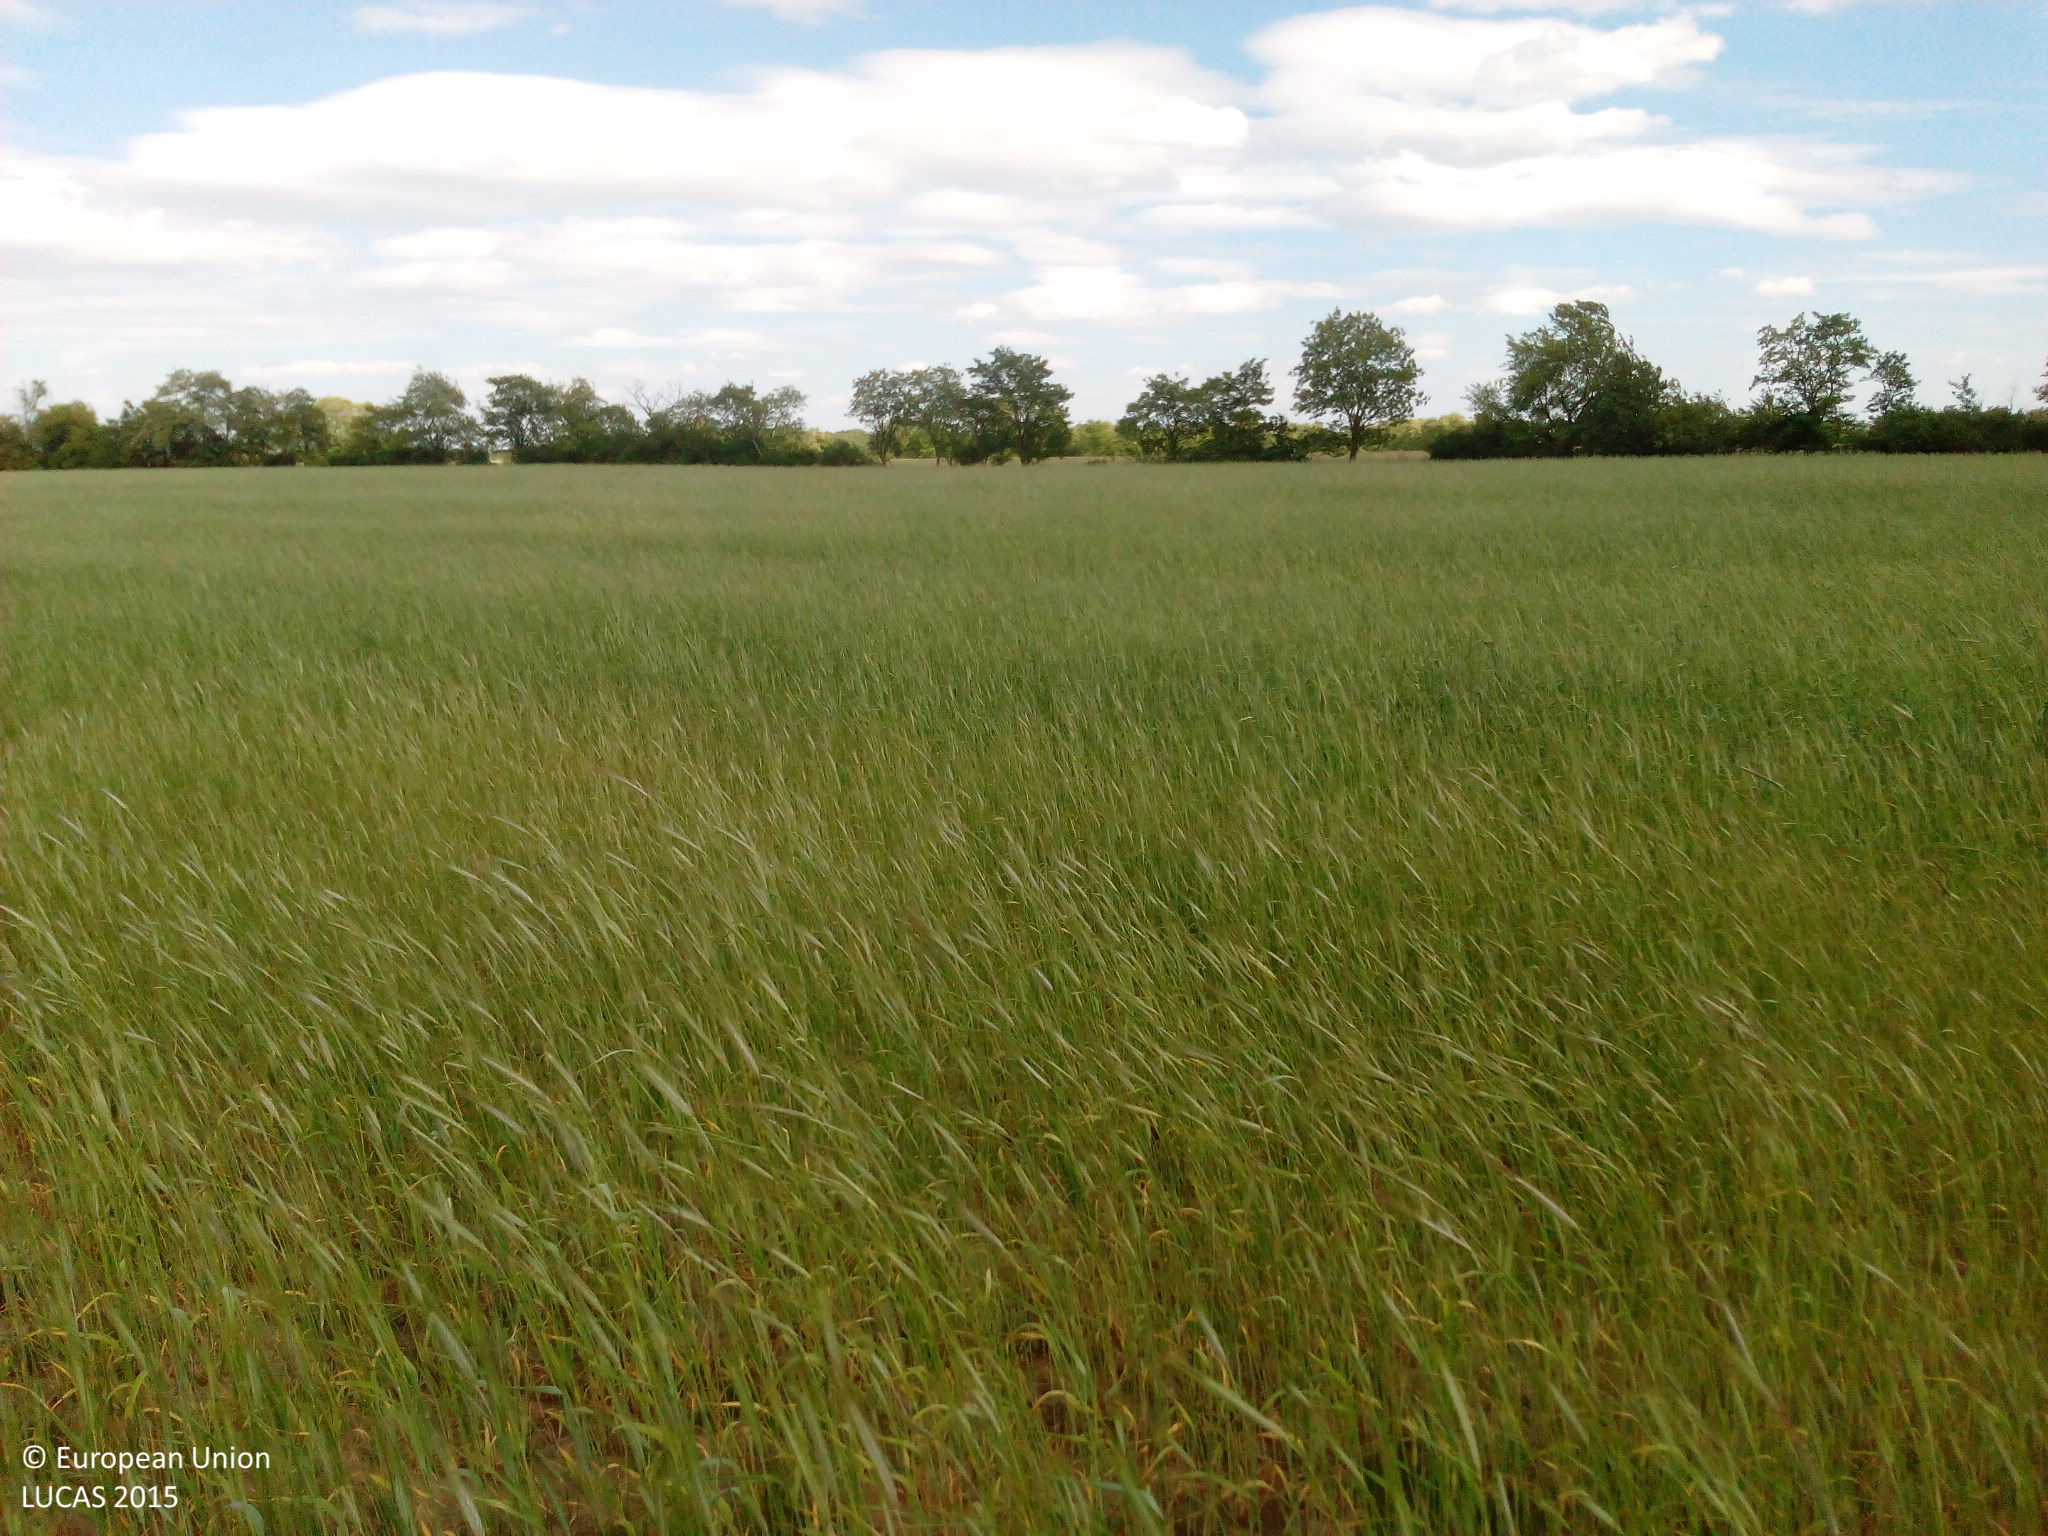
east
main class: Cropland
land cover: Rye
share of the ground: > 75 %
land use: Agriculture (excluding fallow land and kitchen gardens)
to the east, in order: Rye; Abandoned hedges; Rye
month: June
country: DE
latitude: 52.4029
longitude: 12.6013
